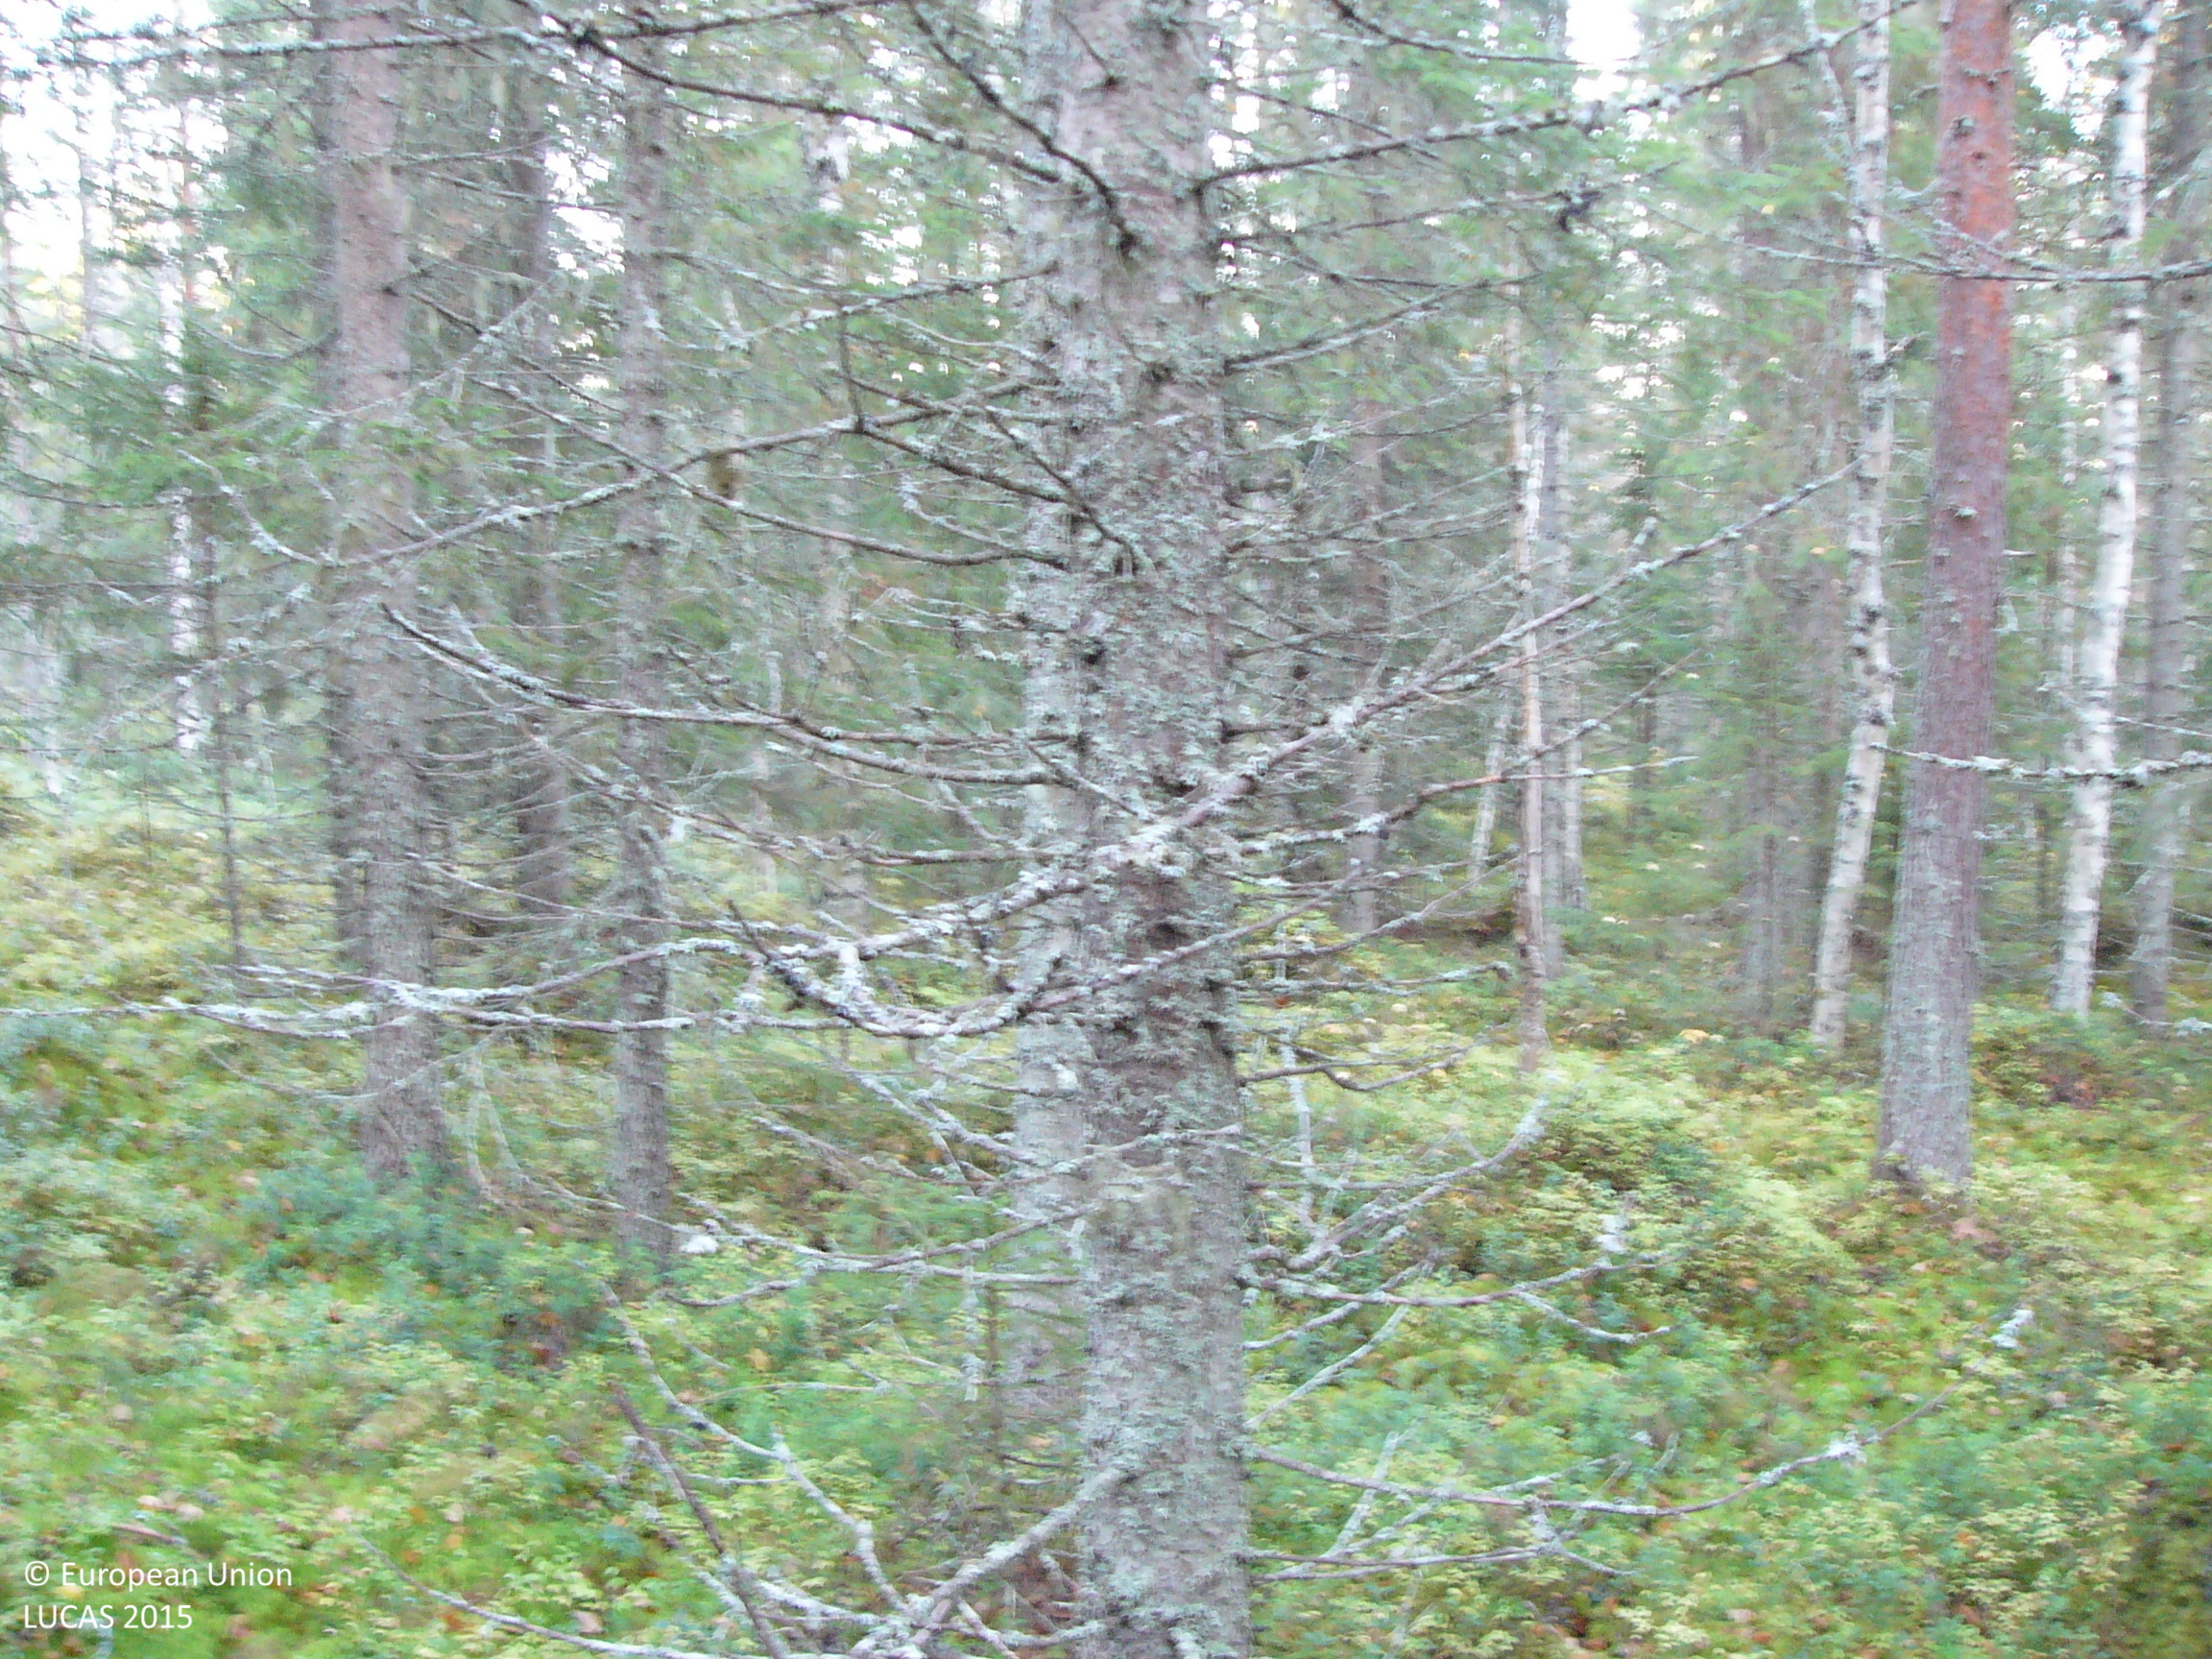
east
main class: Woodland
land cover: Other mixed woodland
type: boreal forest
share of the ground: > 75 %
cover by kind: coniferous forest trees 65 %, broadleaved forest trees 25 %, shrubs 10 %
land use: Forestry
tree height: > 5 m
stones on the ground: < 10 %
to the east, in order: Other mixed woodland; Pine dominated mixed woodland; Spruce dominated mixed woodland; Other coniferous woodland; Pine dominated coniferous woodland; Spruce dominated mixed woodland; Pine dominated mixed woodland; Other coniferous woodland
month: October
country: SE
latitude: 64.0422
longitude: 17.8132
